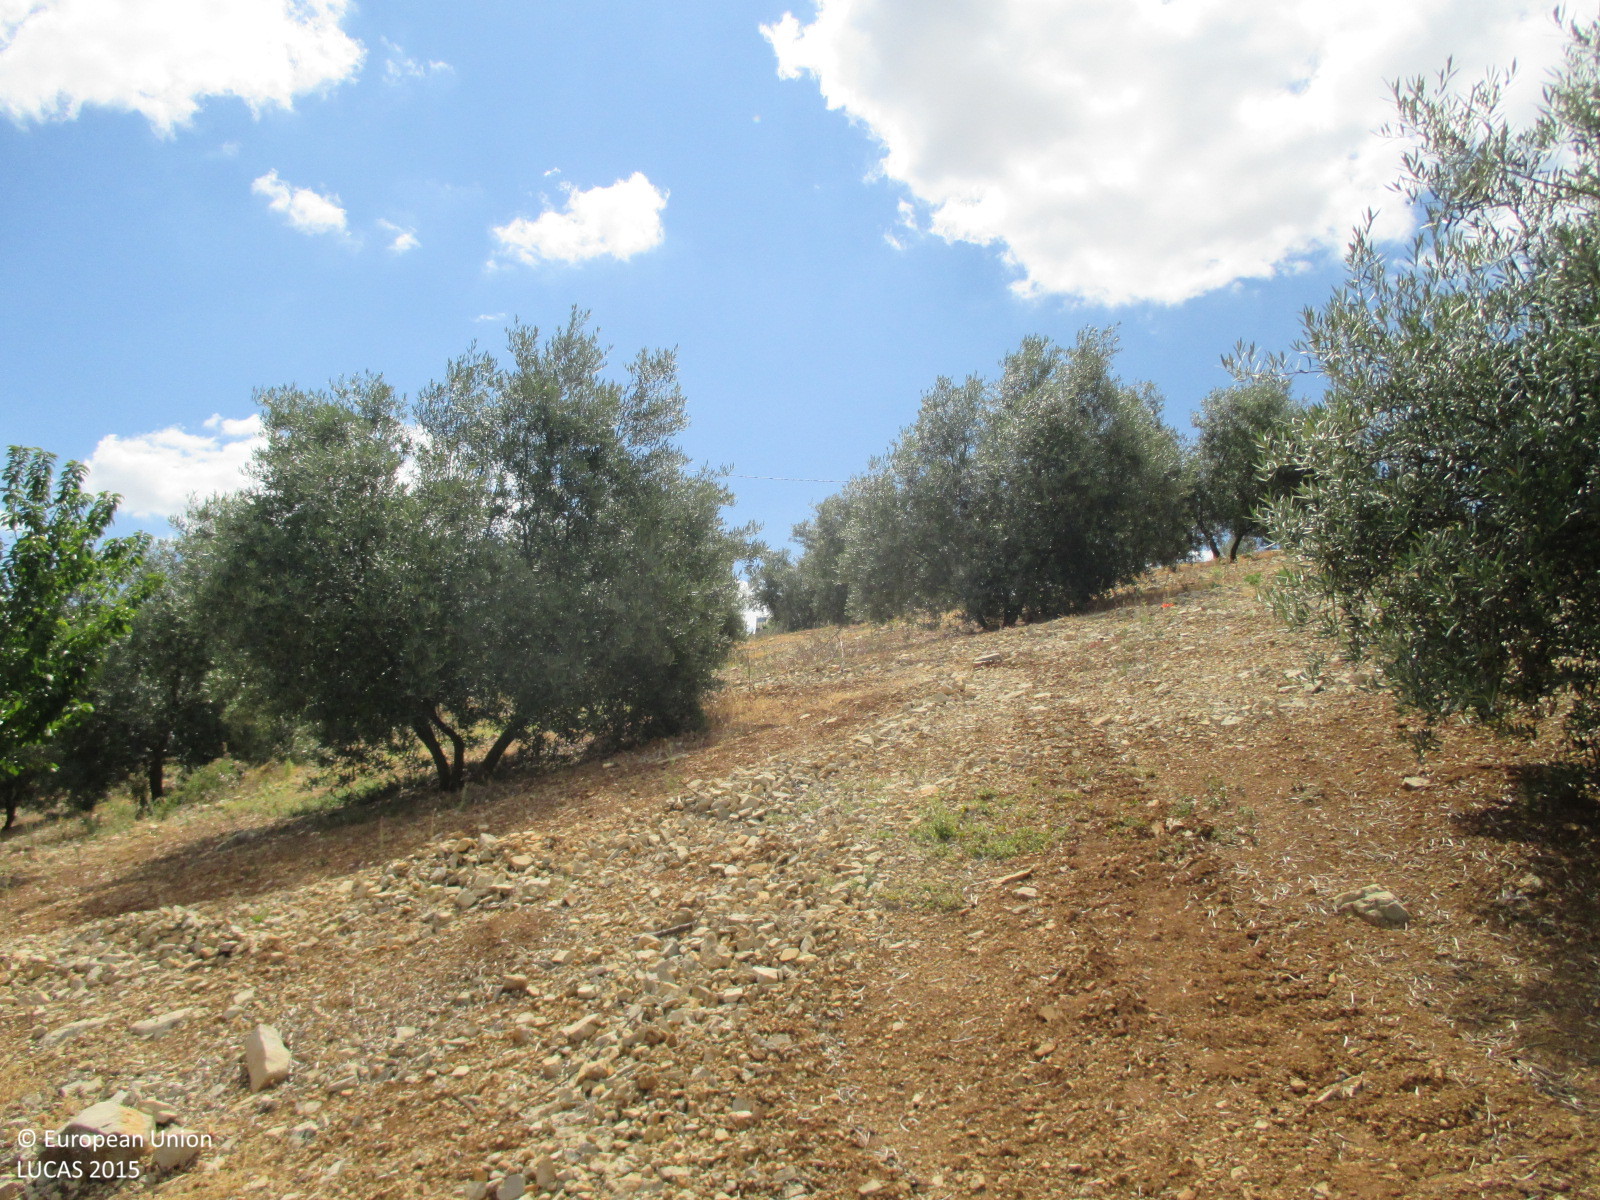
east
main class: Cropland
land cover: Olive groves
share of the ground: 10 - 25 %
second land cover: Other bare soil
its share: > 75 %
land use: Agriculture (excluding fallow land and kitchen gardens)
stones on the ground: < 10 %
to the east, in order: Olive groves; Other bare soil; Electric lines; Olive groves; Electric lines; Olive groves; Electric lines; Olive groves; Electric lines; Olive groves; Grass margins; Tracks; Grass margins; Olive groves; Shrubland with sparse tree cover
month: June
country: ES
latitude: 37.3565
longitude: -4.0756
